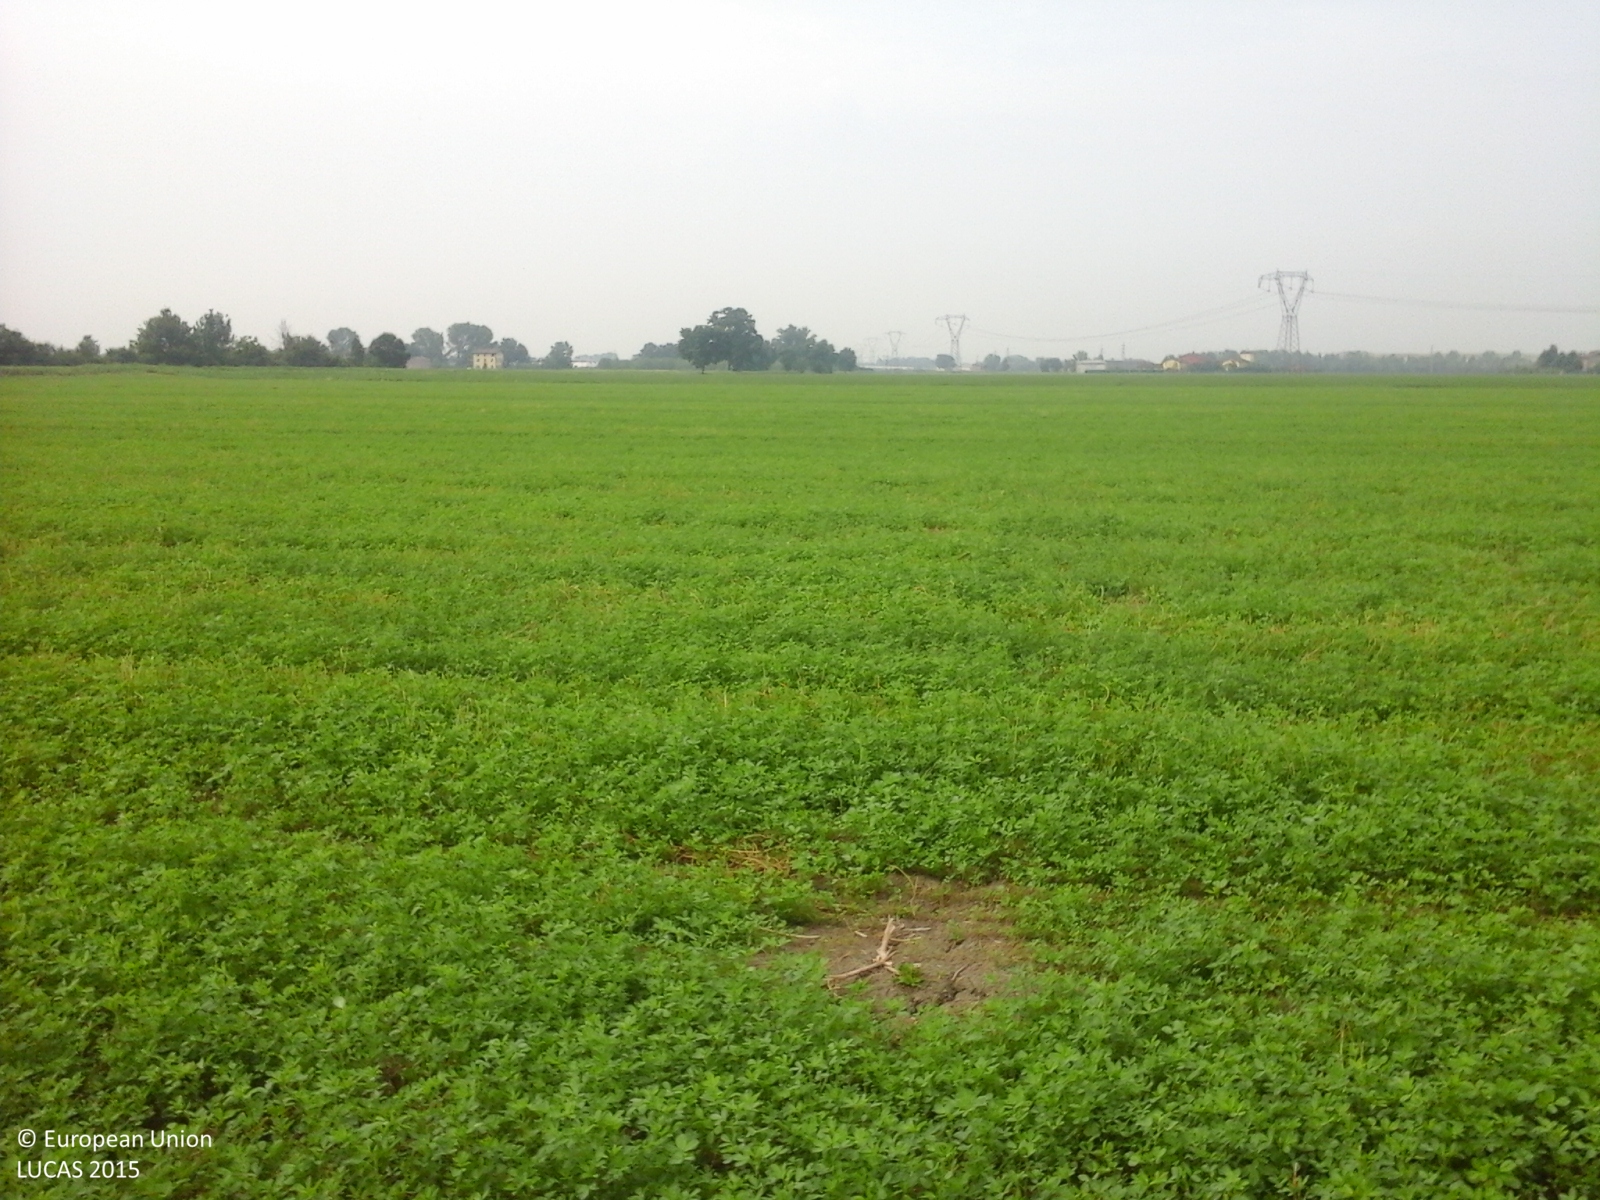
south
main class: Cropland
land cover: Lucerne
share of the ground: > 75 %
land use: Agriculture (excluding fallow land and kitchen gardens)
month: June
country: IT
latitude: 44.6885
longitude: 10.9947
